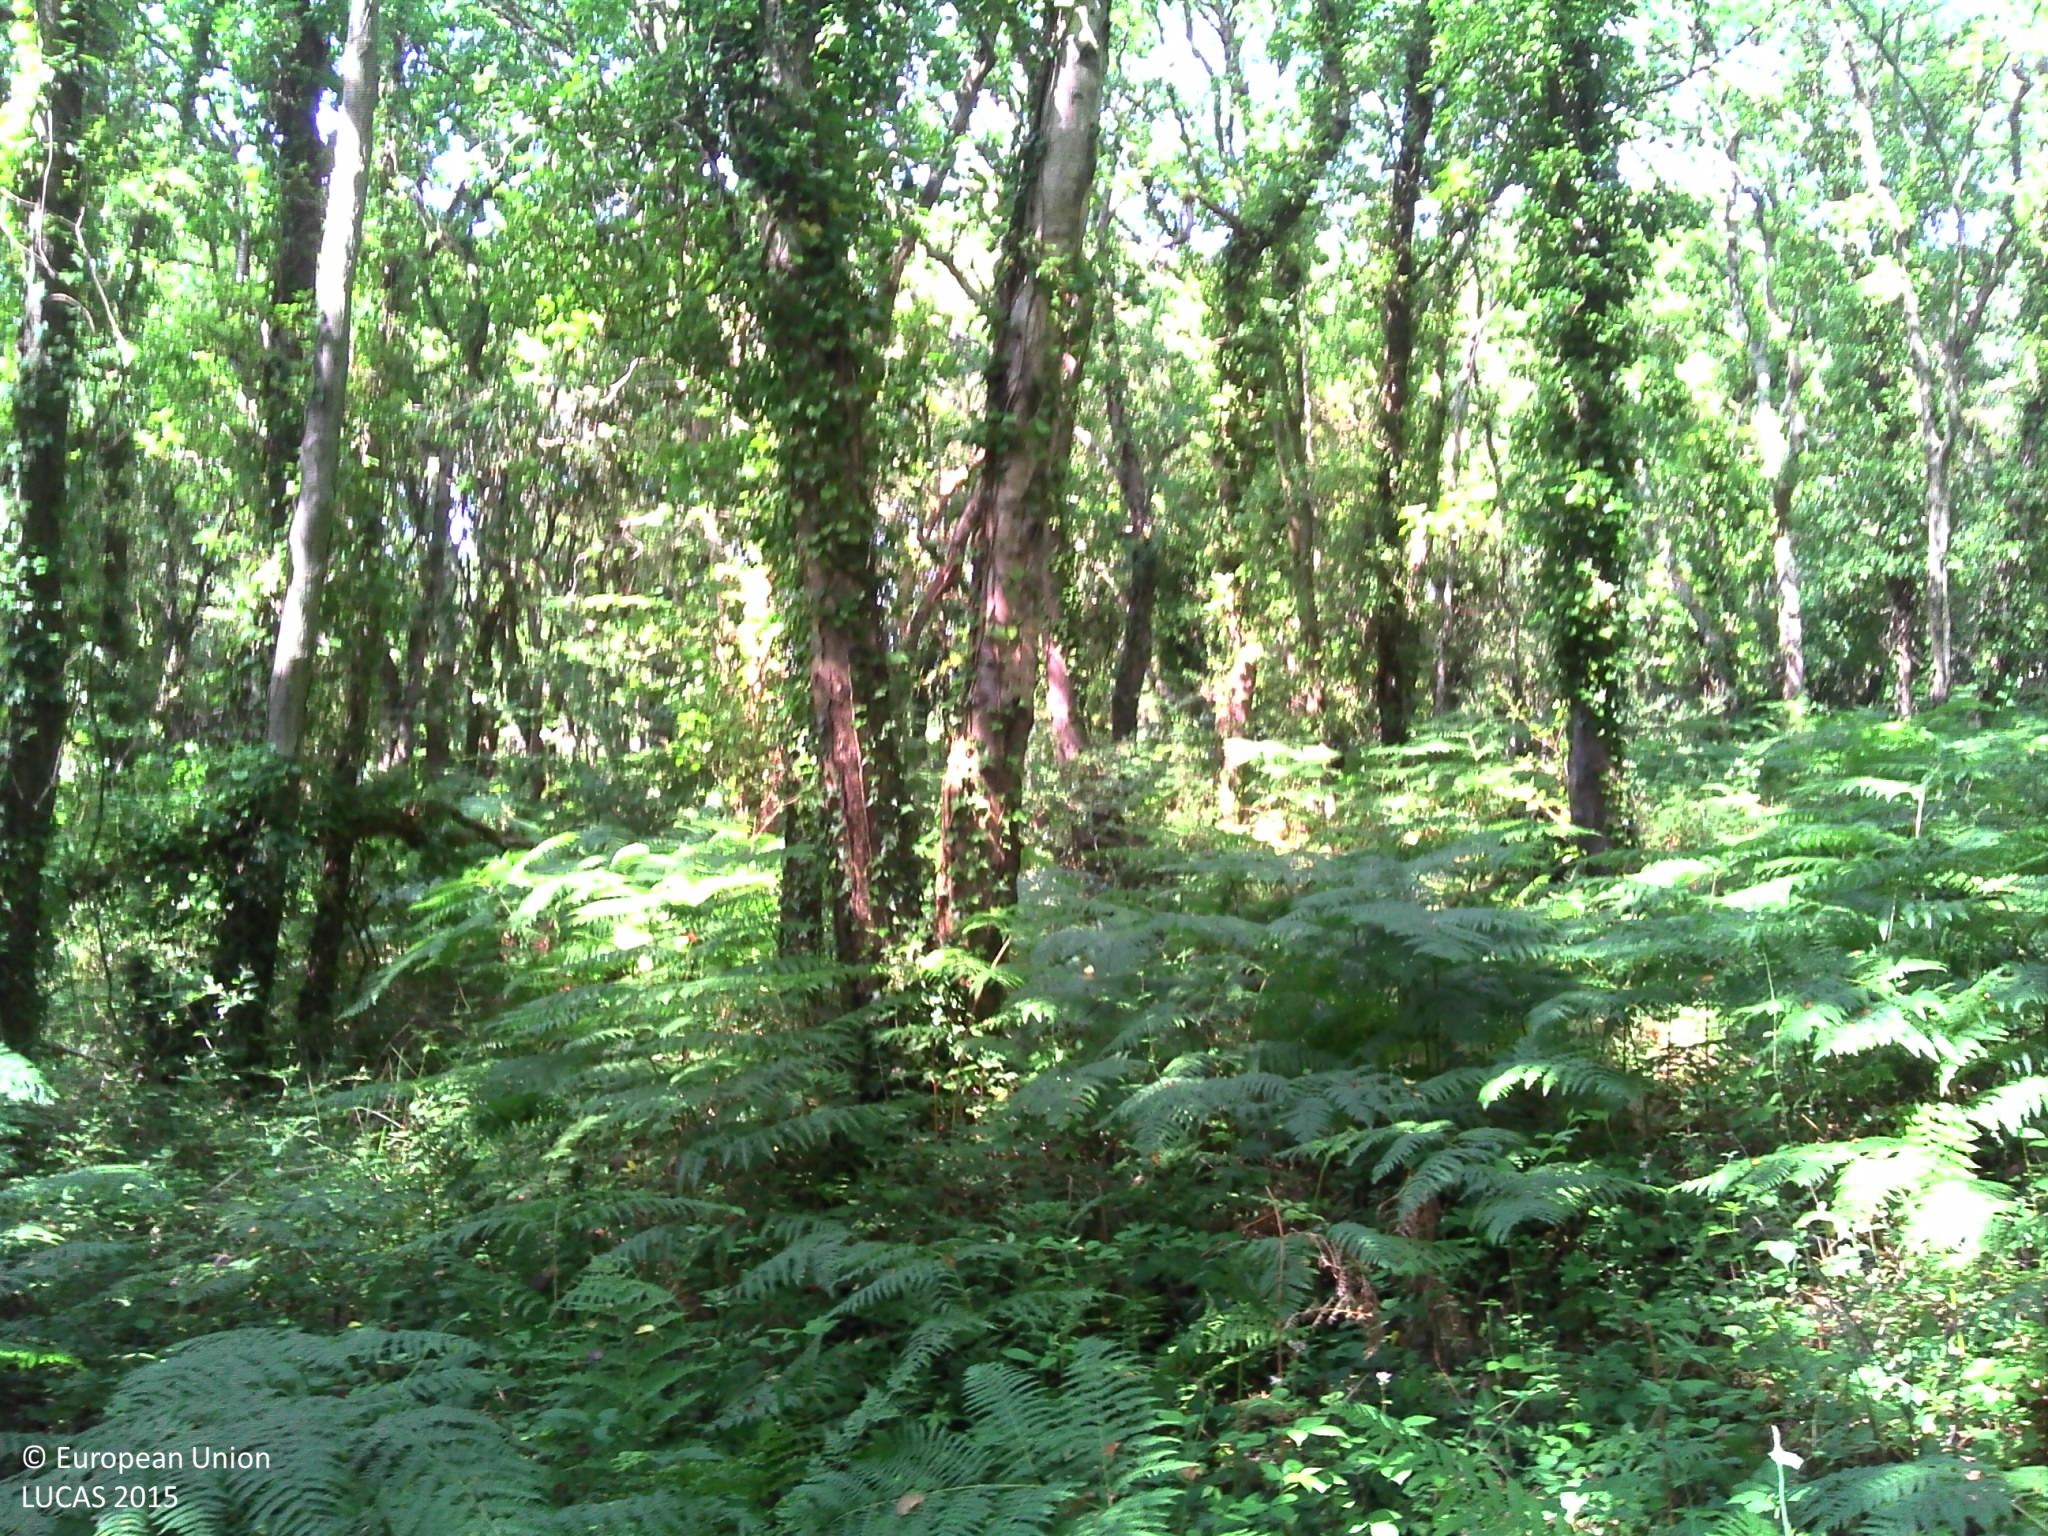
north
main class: Woodland
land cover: Broadleaved woodland
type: mesophytic deciduous forest
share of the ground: > 75 %
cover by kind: herbaceous plants 80 %, broadleaved forest trees 20 %
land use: Forestry
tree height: > 5 m
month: July
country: FR
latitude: 48.7911
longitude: -3.5153
